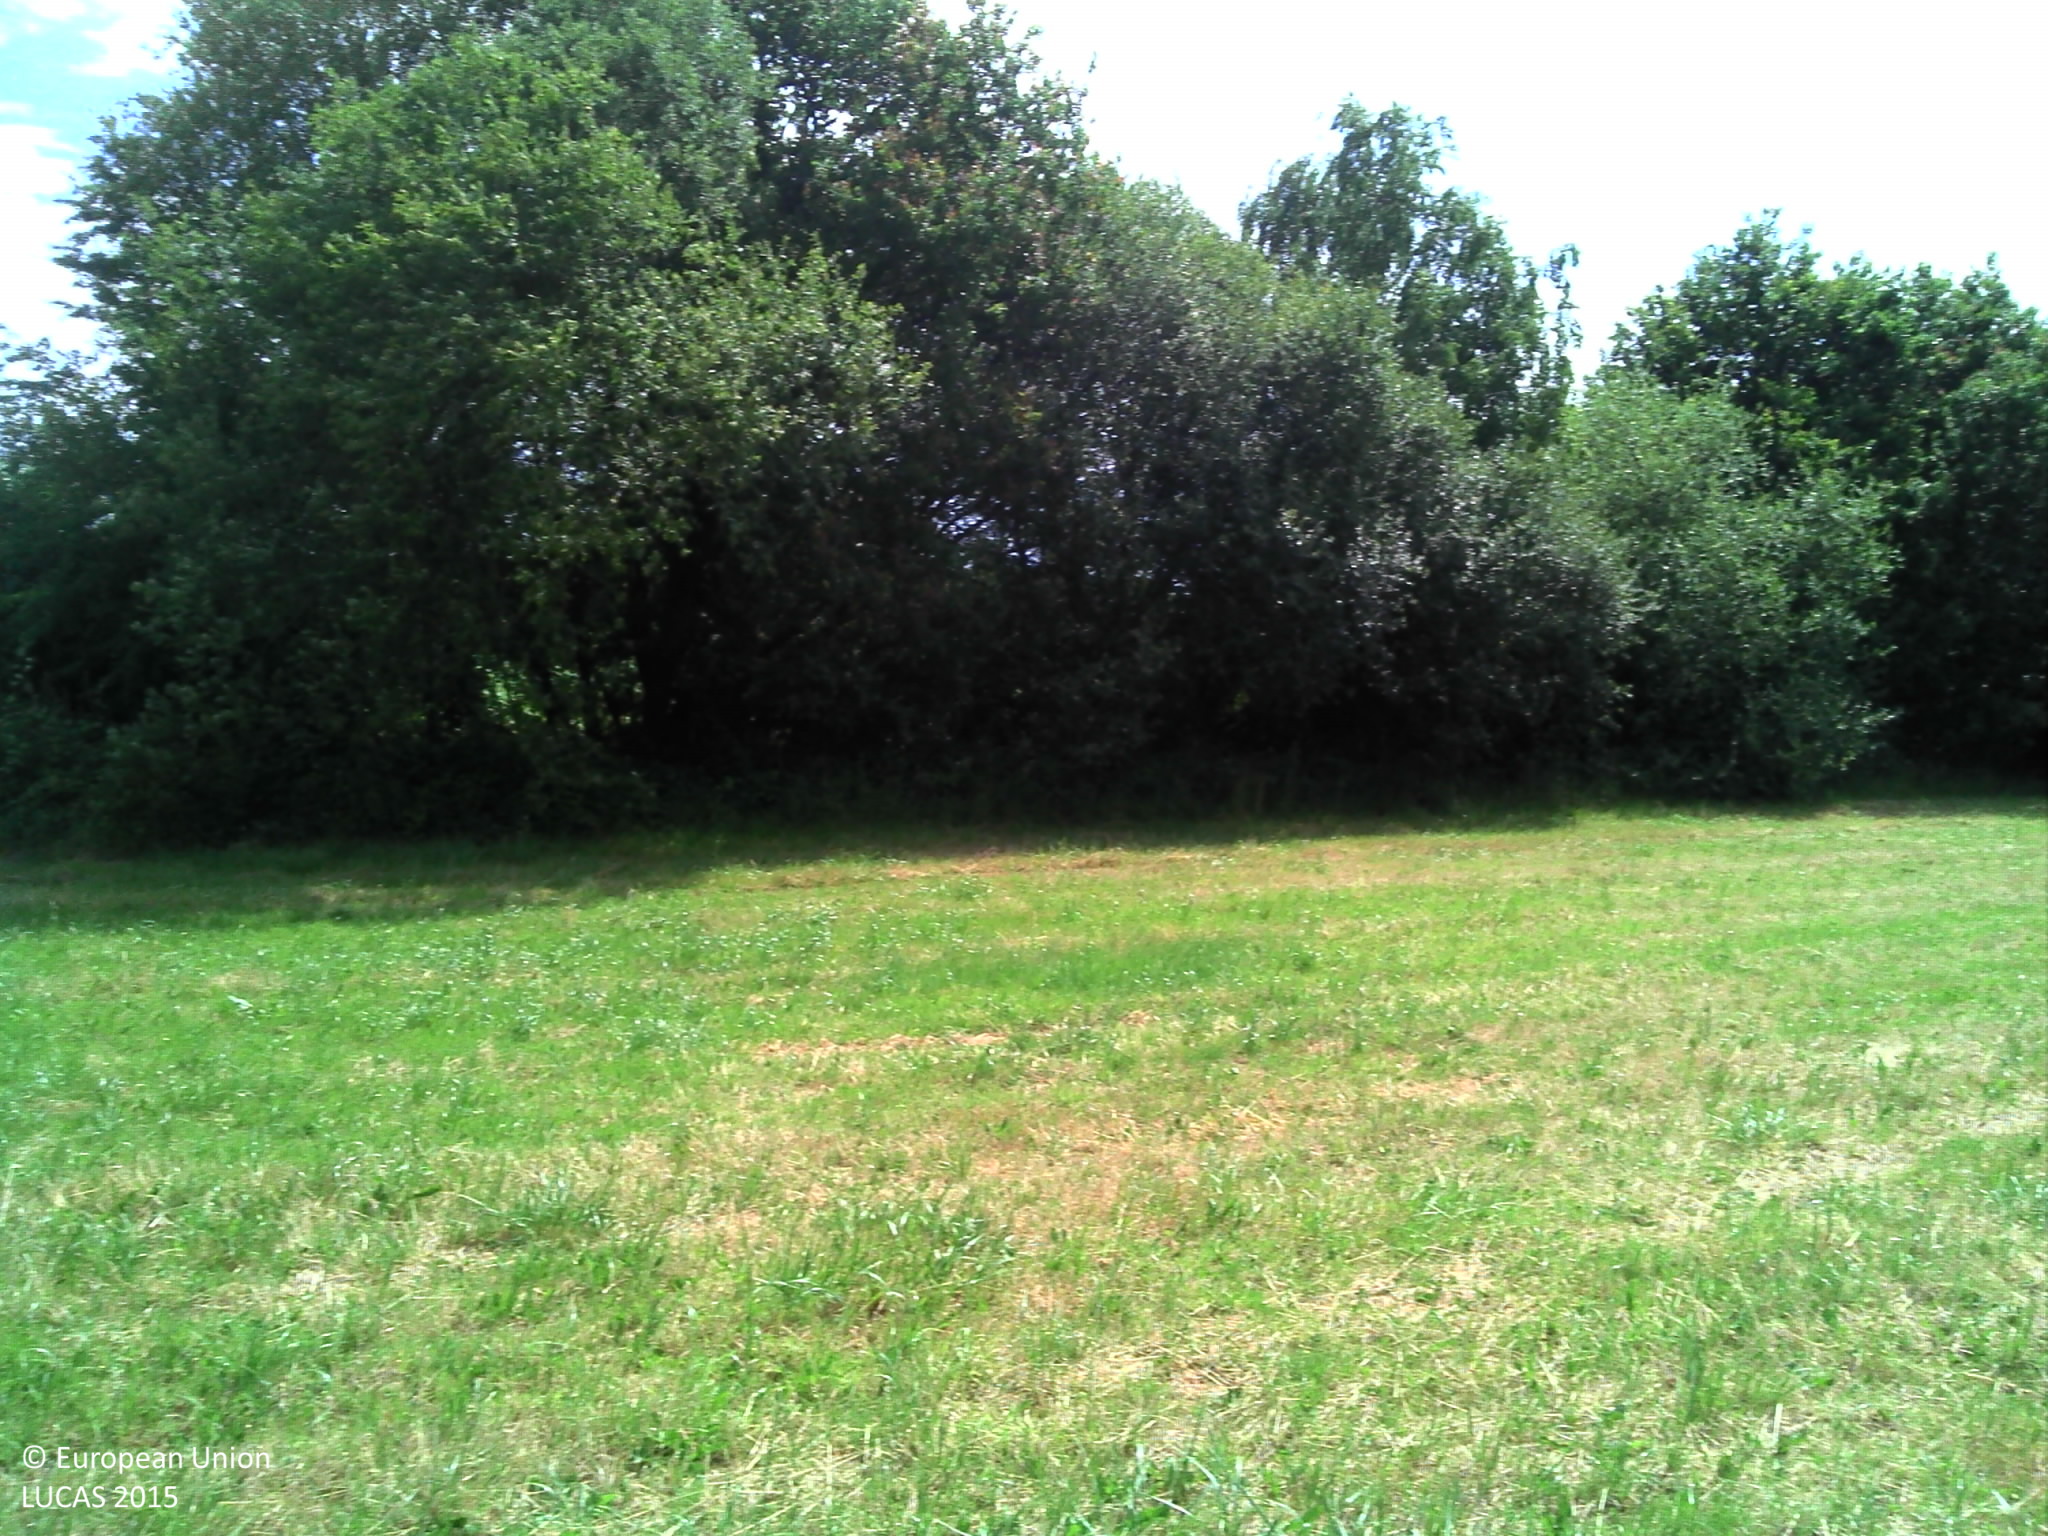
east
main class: Grassland
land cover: Grassland without tree/shrub cover
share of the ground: > 75 %
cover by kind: herbaceous plants 100 %
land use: Agriculture (excluding fallow land and kitchen gardens)
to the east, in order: Grassland without tree/shrub cover; Abandoned hedges; Maize; Lines of trees; Electric lines; Ditches and canals; Grass margins; Paved roads, cycling and walking lanes; Grass margins; Ditches and canals; Abandoned hedges; Common wheat
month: June
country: FR
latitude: 47.9229
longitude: -2.0568
